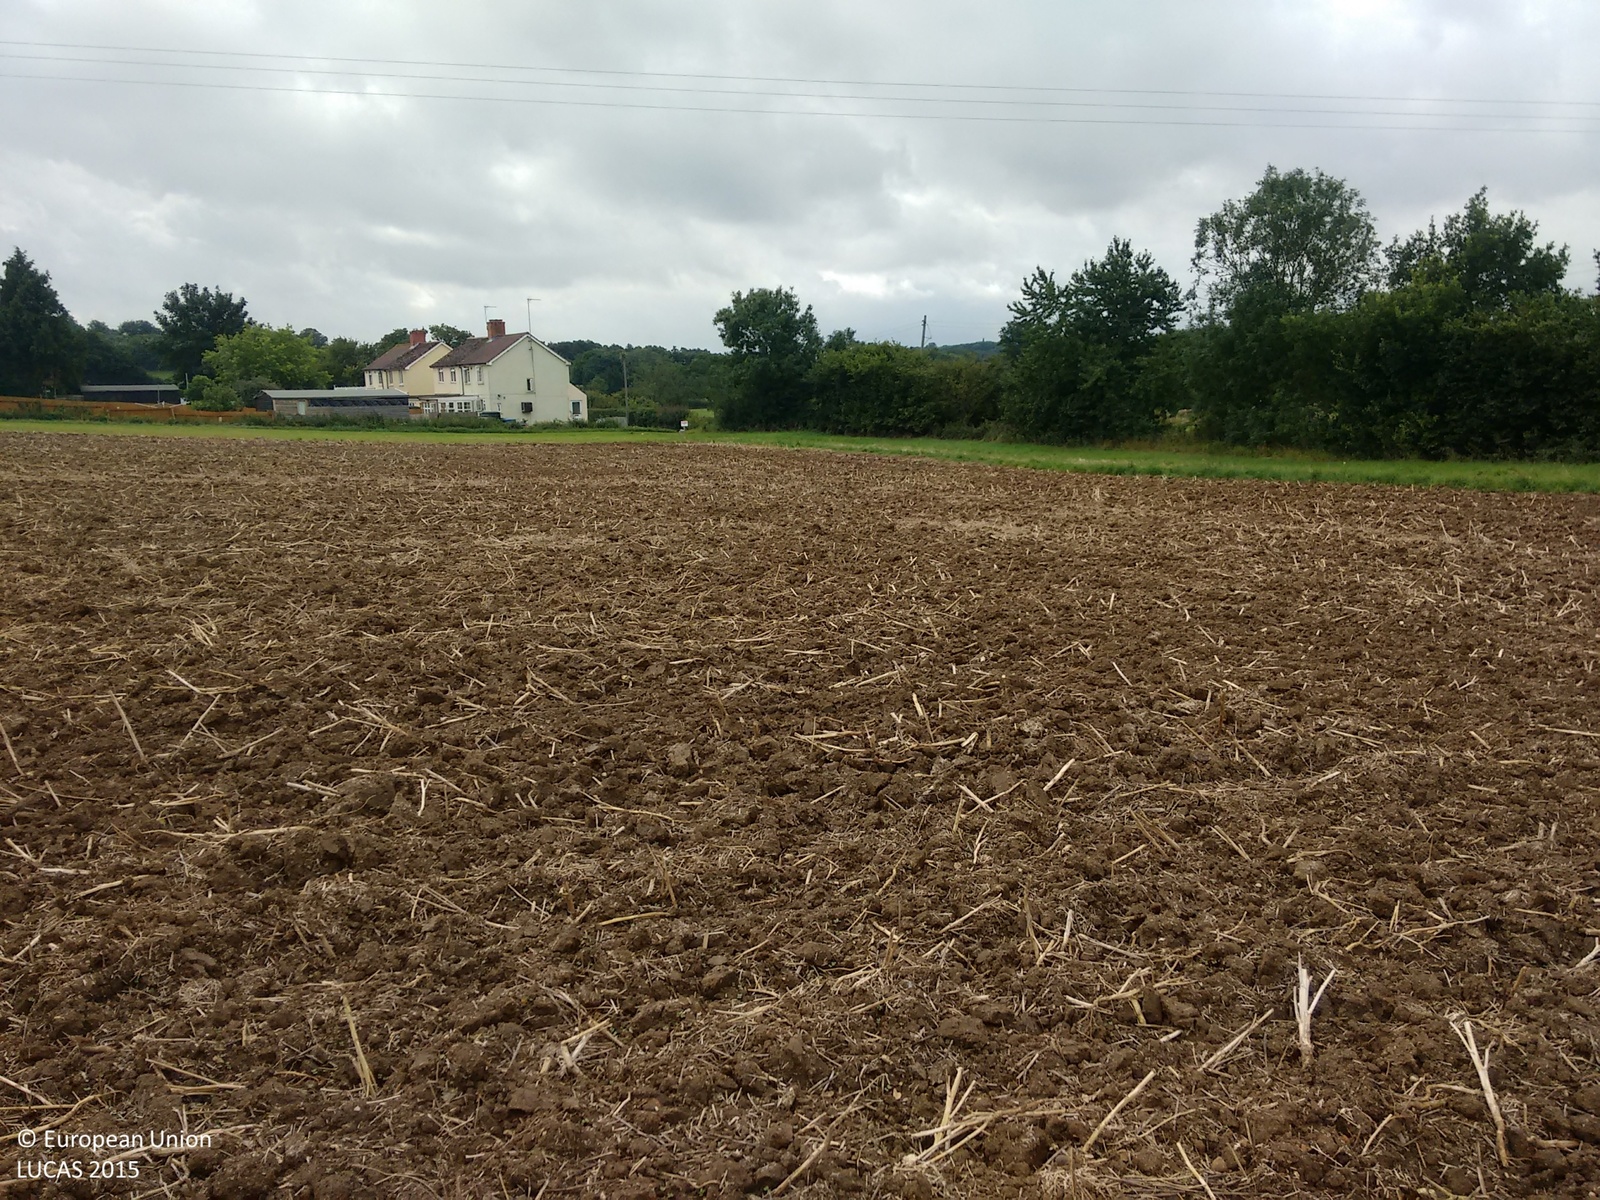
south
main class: Cropland
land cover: Rape and turnip rape
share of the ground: < 10 %
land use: Agriculture (excluding fallow land and kitchen gardens)
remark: Harvested field
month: August
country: GB
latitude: 52.1005
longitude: 0.9103
